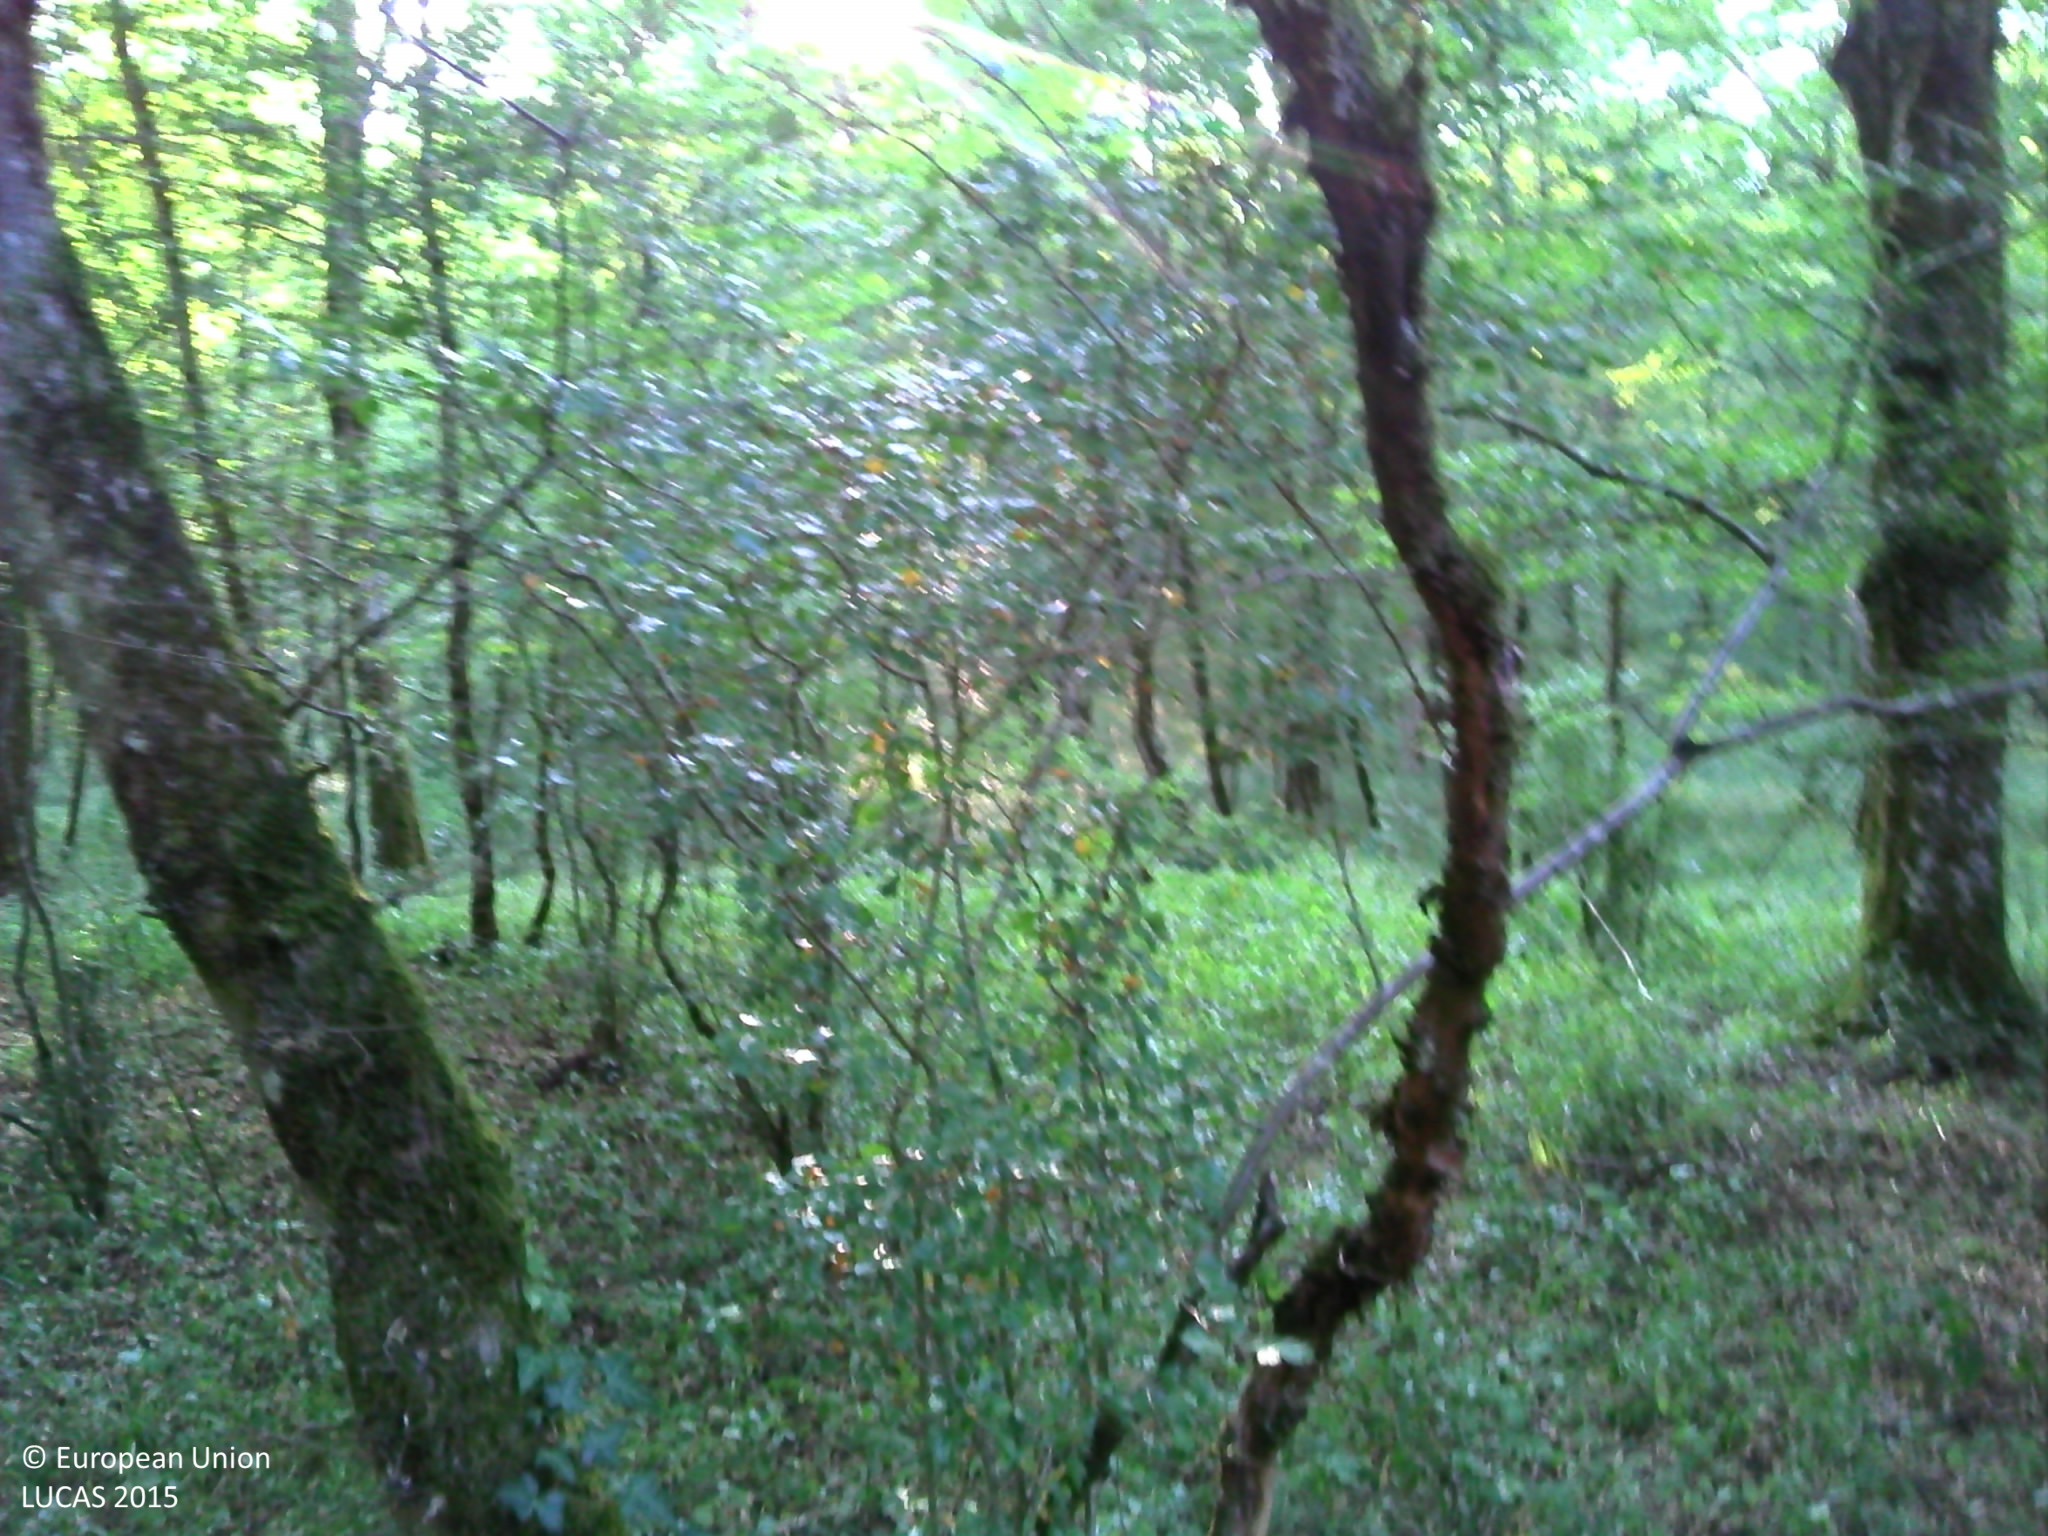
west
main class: Woodland
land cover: Broadleaved woodland
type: mesophytic deciduous forest
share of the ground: > 75 %
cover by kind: broadleaved forest trees 75 %, shrubs 10 %, lichens and mosses 10 %, herbaceous plants 5 %
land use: Forestry
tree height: > 5 m
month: July
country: FR
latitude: 48.0199
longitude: 4.9980
